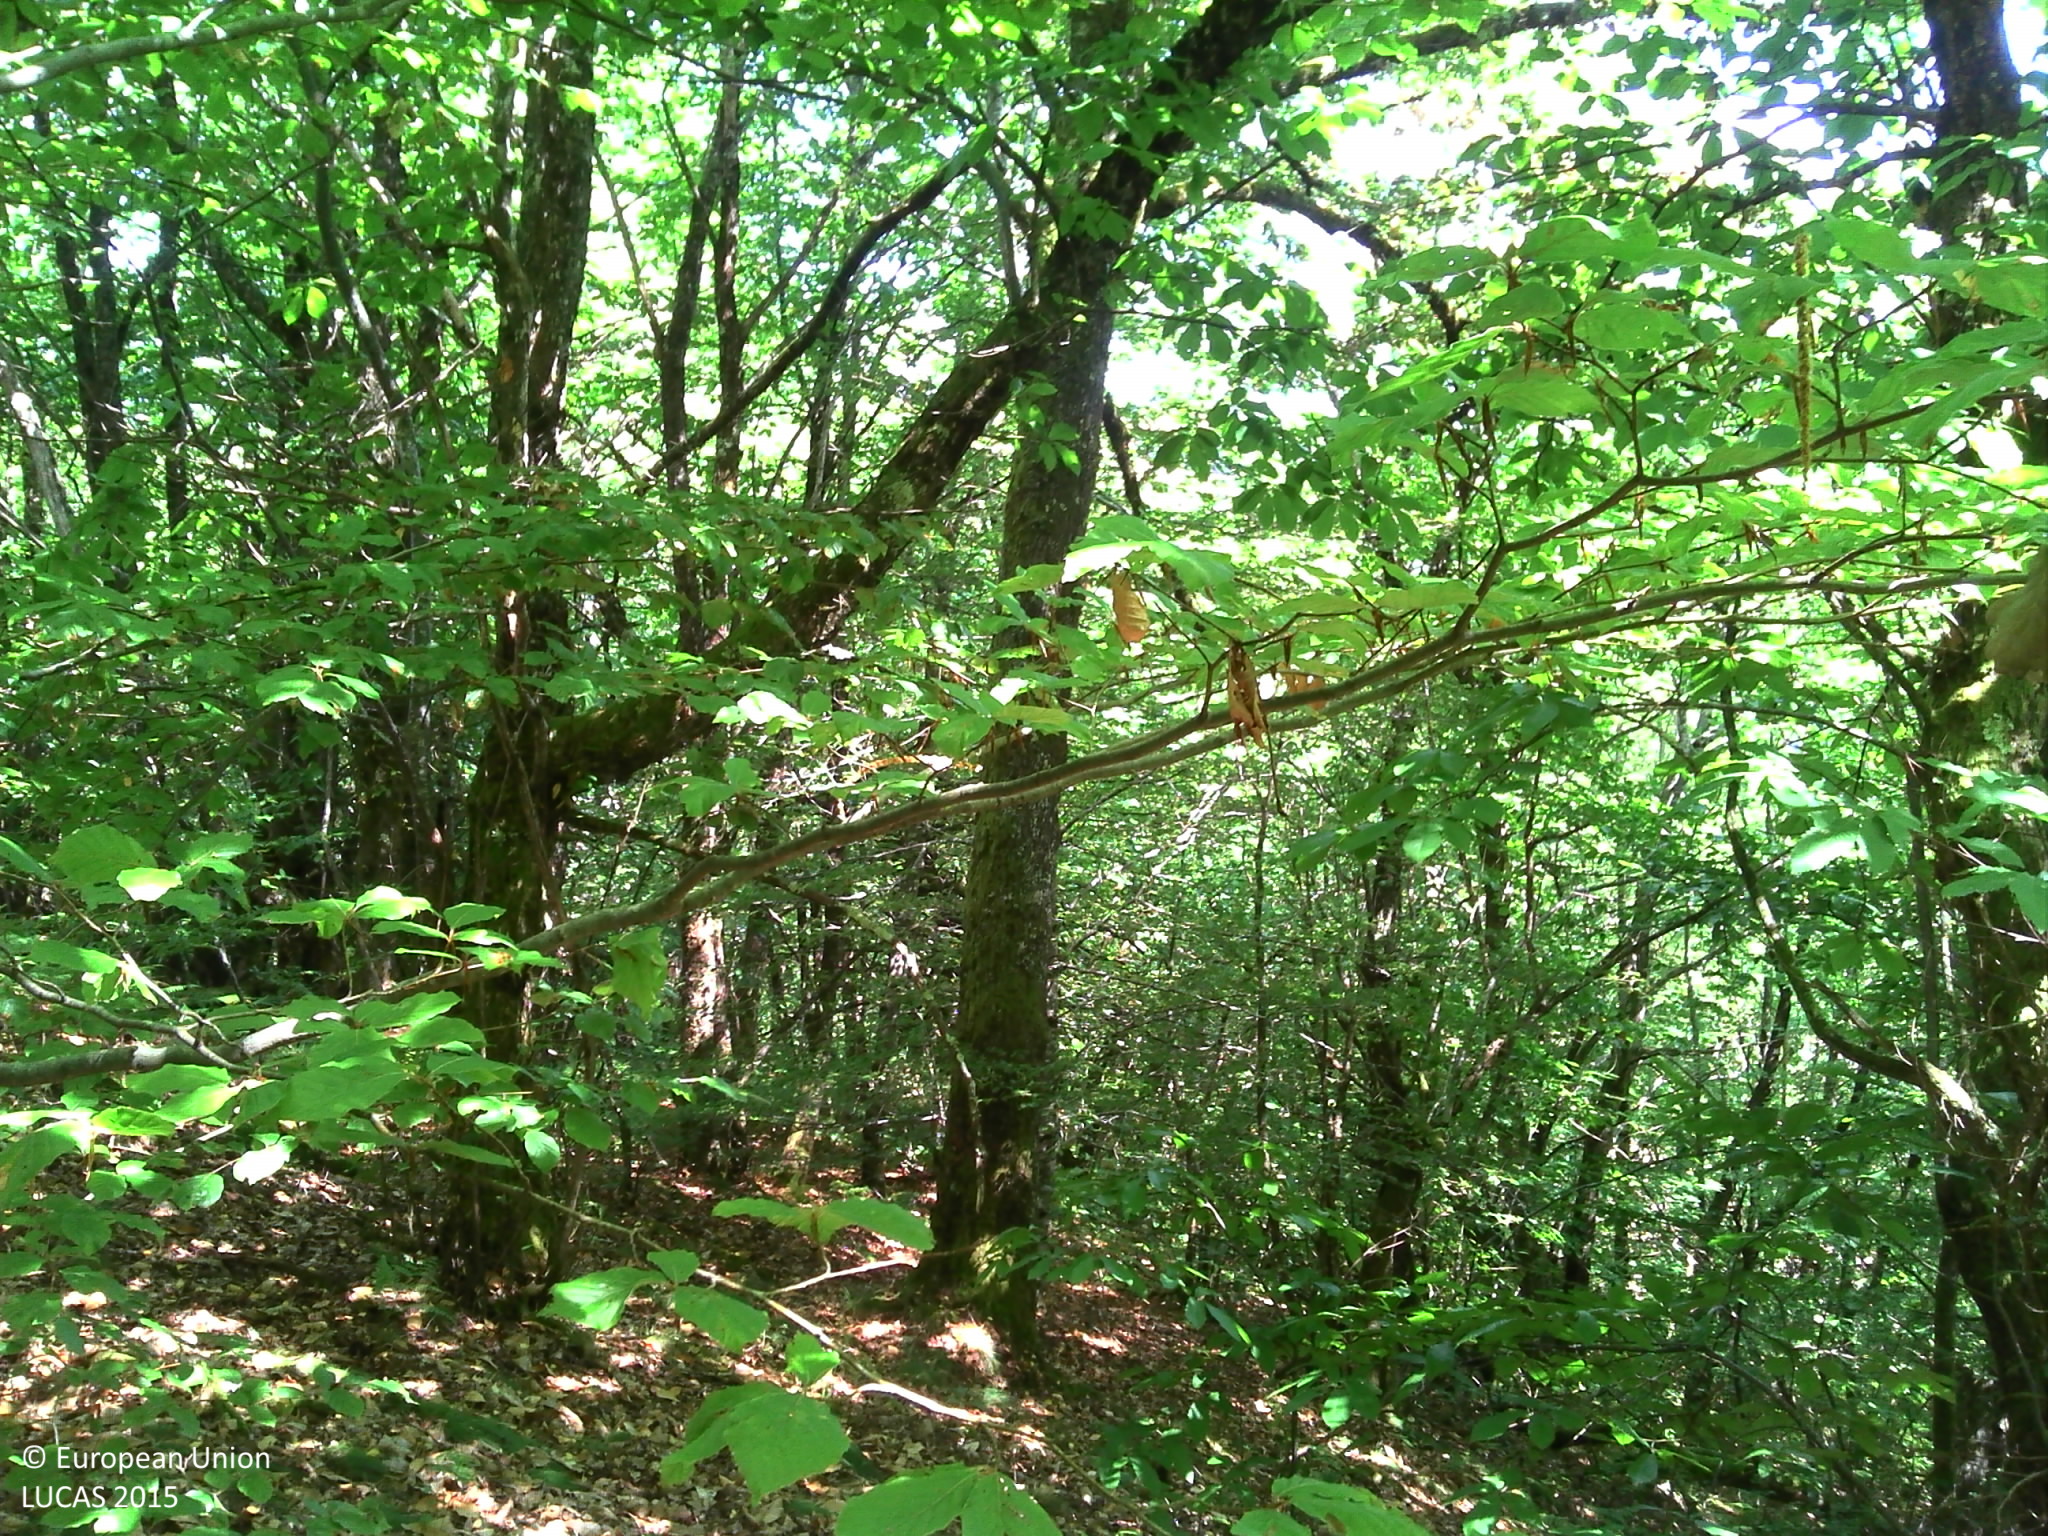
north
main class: Woodland
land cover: Broadleaved woodland
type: mesophytic deciduous forest
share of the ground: > 75 %
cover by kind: broadleaved forest trees 95 %, shrubs 5 %
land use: Forestry
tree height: > 5 m
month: July
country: FR
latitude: 44.7514
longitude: 2.5364
